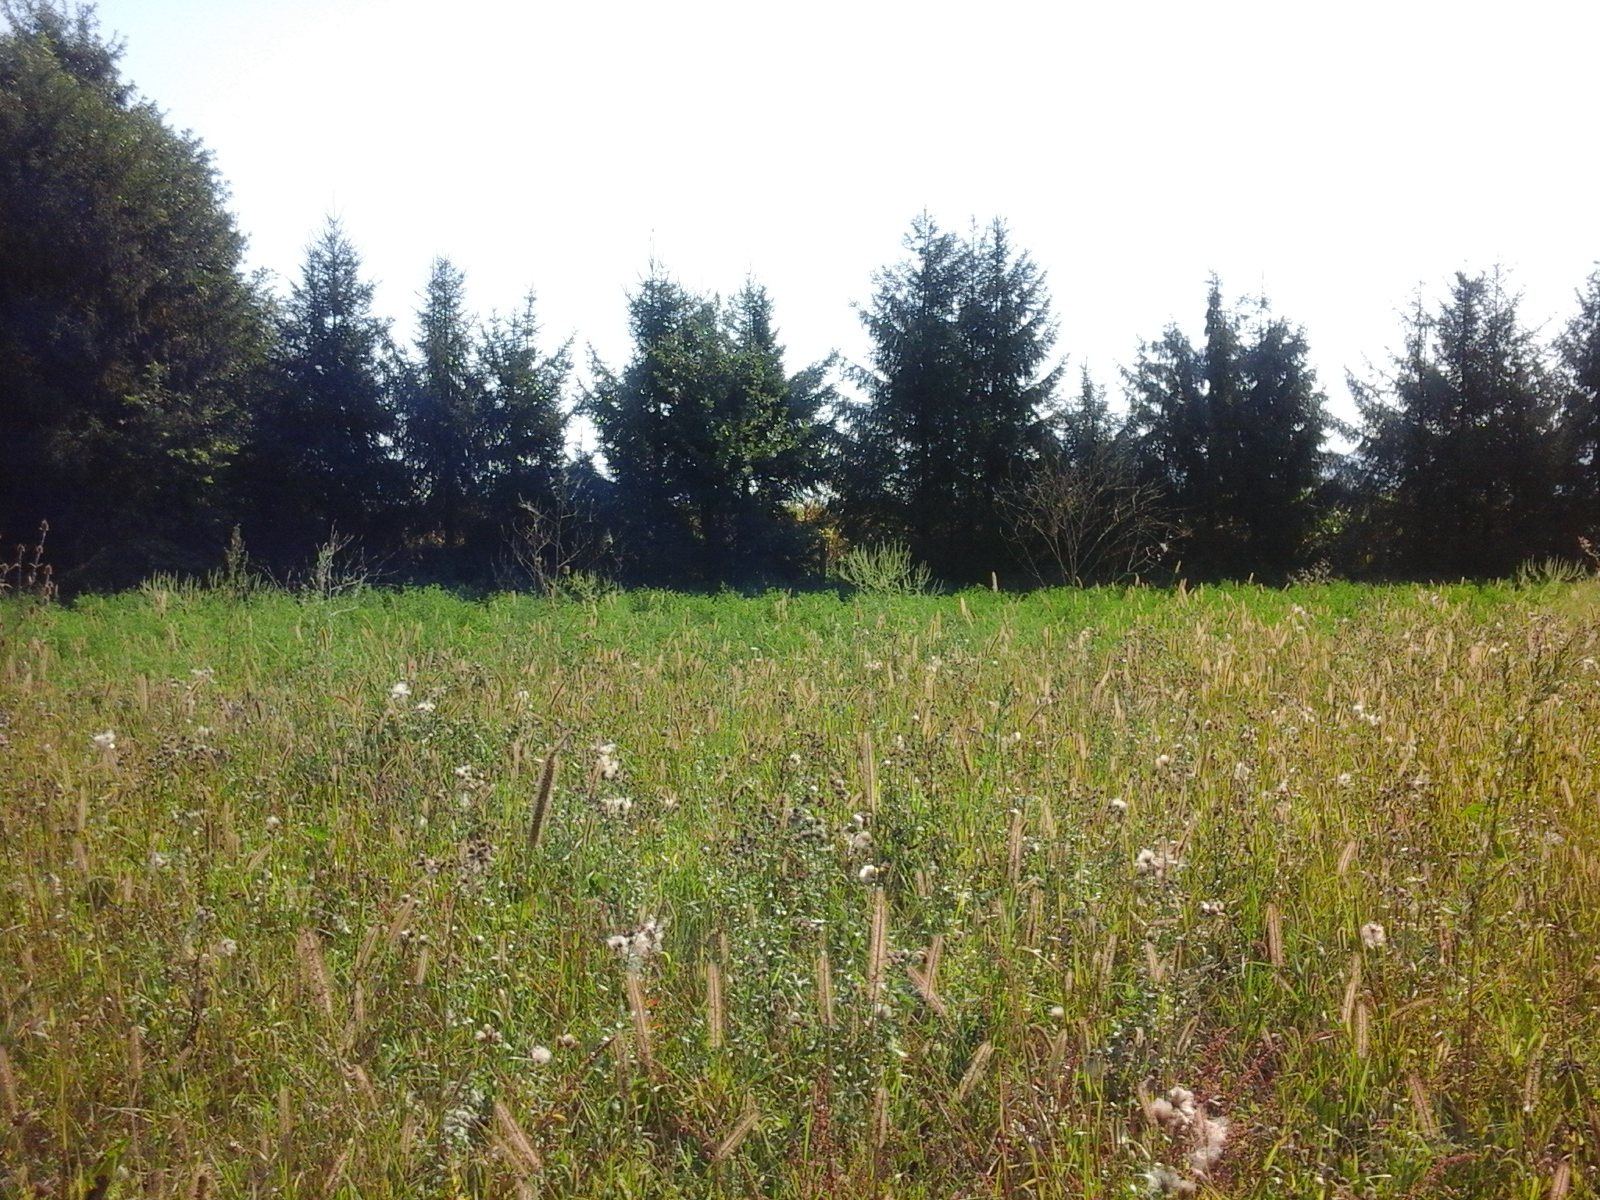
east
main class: Grassland
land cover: Spontaneously vegetated surfaces
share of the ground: > 75 %
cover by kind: herbaceous plants 100 %
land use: Agriculture (excluding fallow land and kitchen gardens)
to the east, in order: Spontaneously vegetated surfaces; Lucerne; Fences; Abandoned hedges; Grassland without tree/shrub cover; Fences; Lucerne; Grass margins; Tracks; Grass margins; Maize
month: August
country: RO
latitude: 45.9395
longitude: 22.6783
